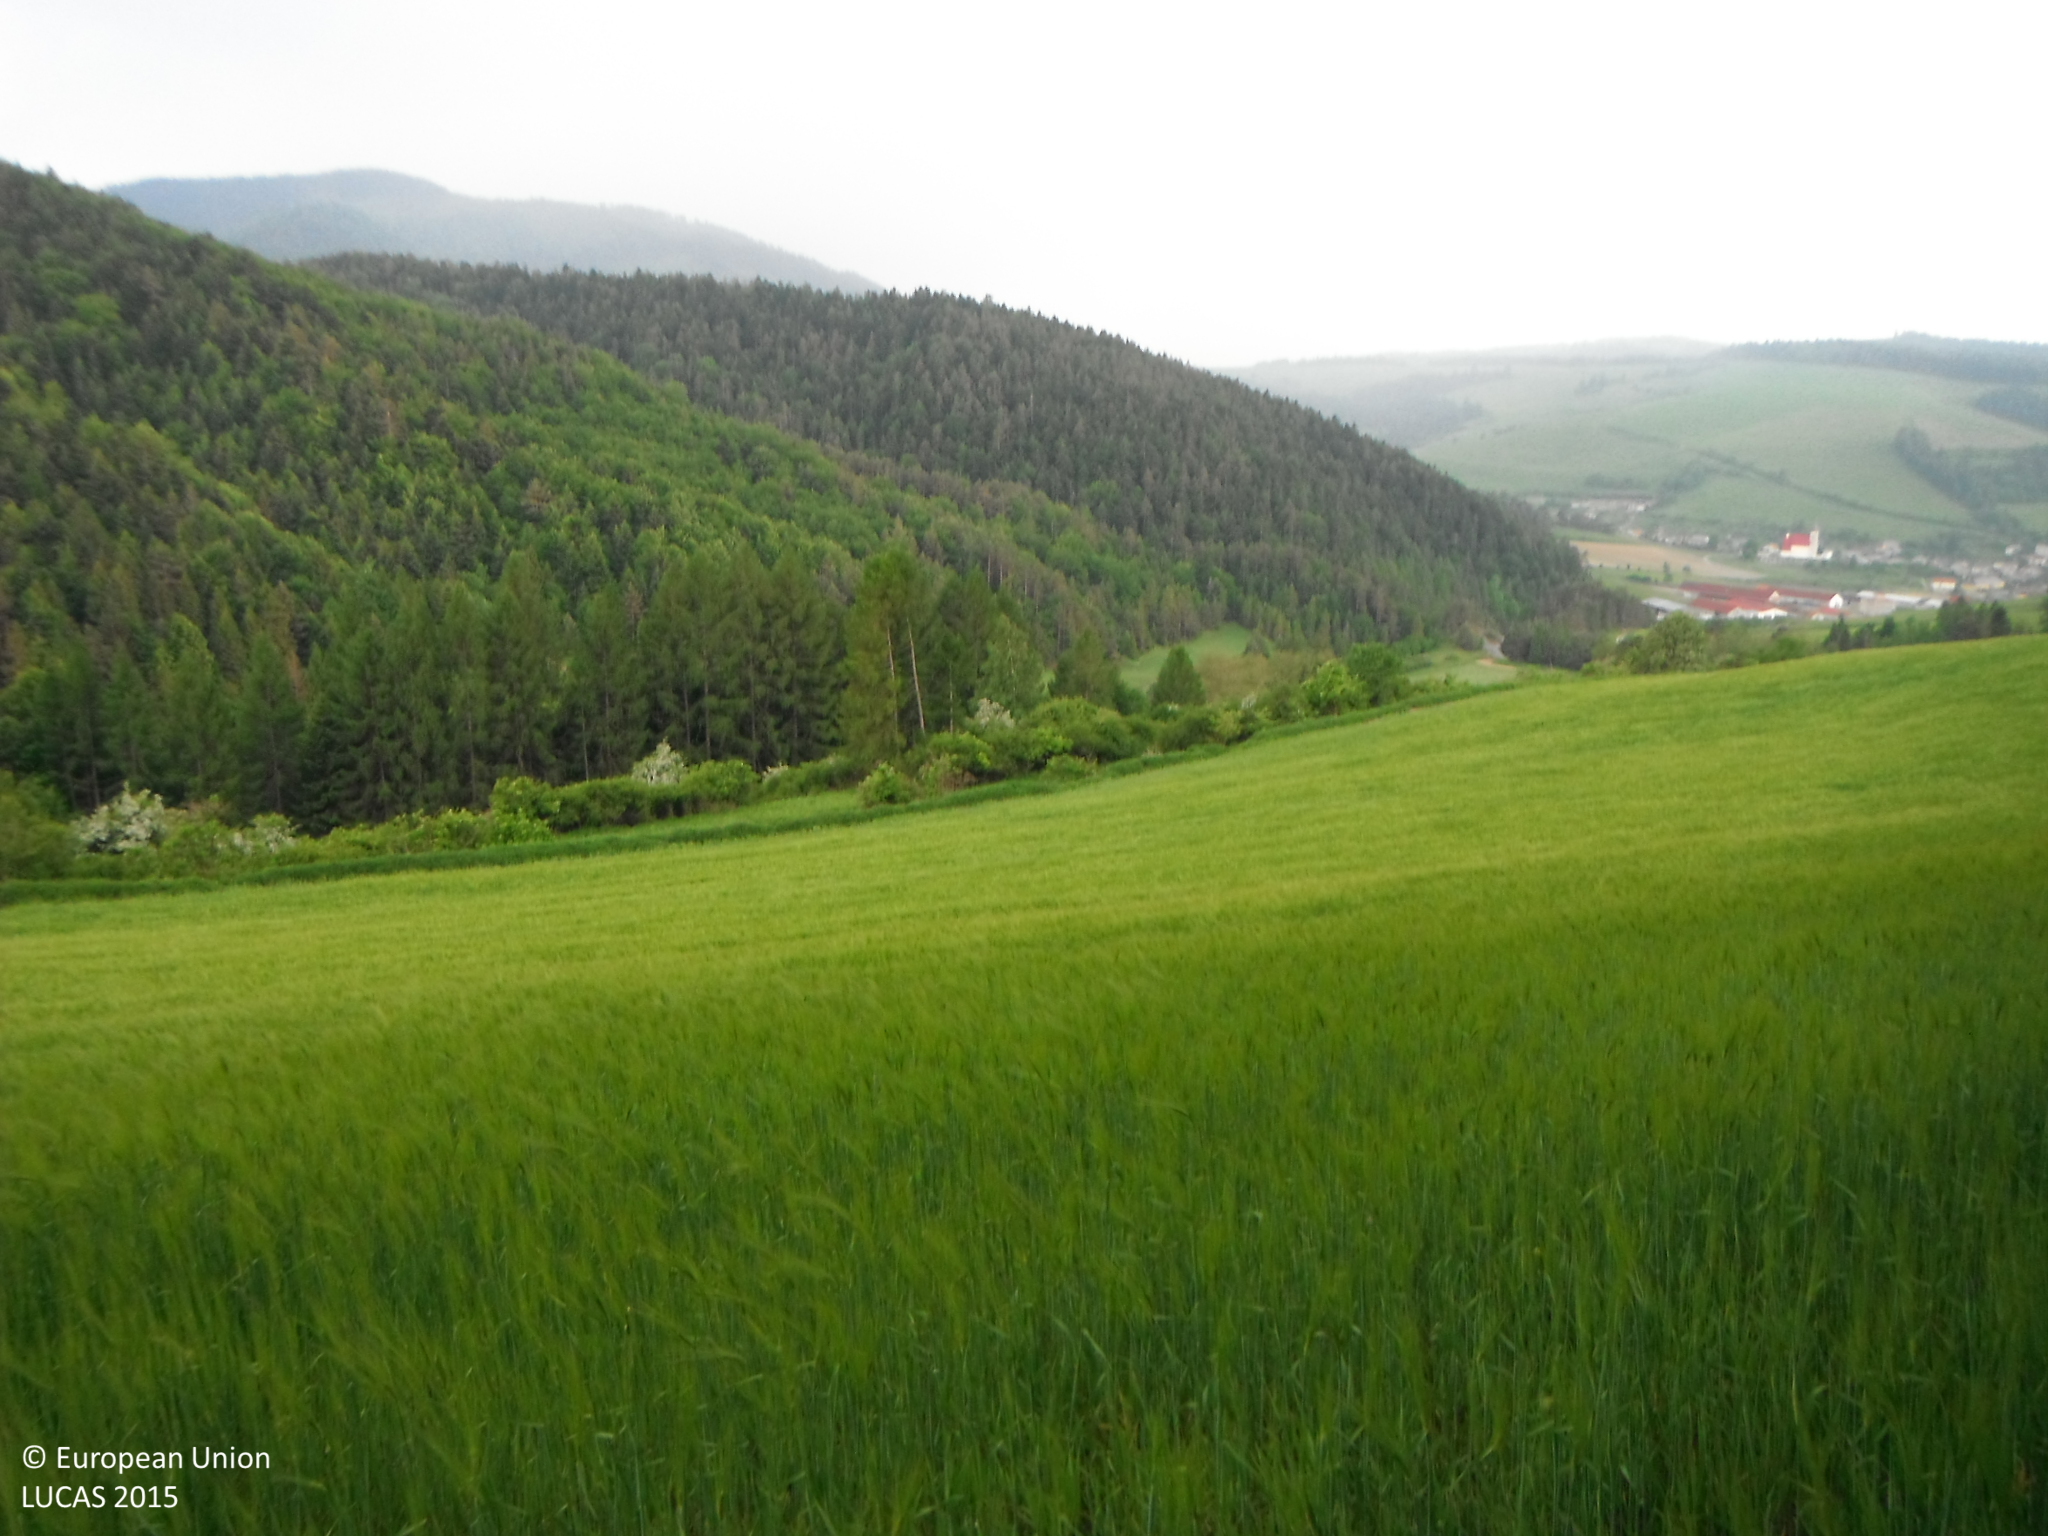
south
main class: Shrubland
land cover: Shrubland with sparse tree cover
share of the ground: > 75 %
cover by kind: shrubs 95 %, broadleaved forest trees 5 %
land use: Semi-natural and natural areas not in use
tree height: > 5 m
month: June
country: SK
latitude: 49.0821
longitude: 20.8705
